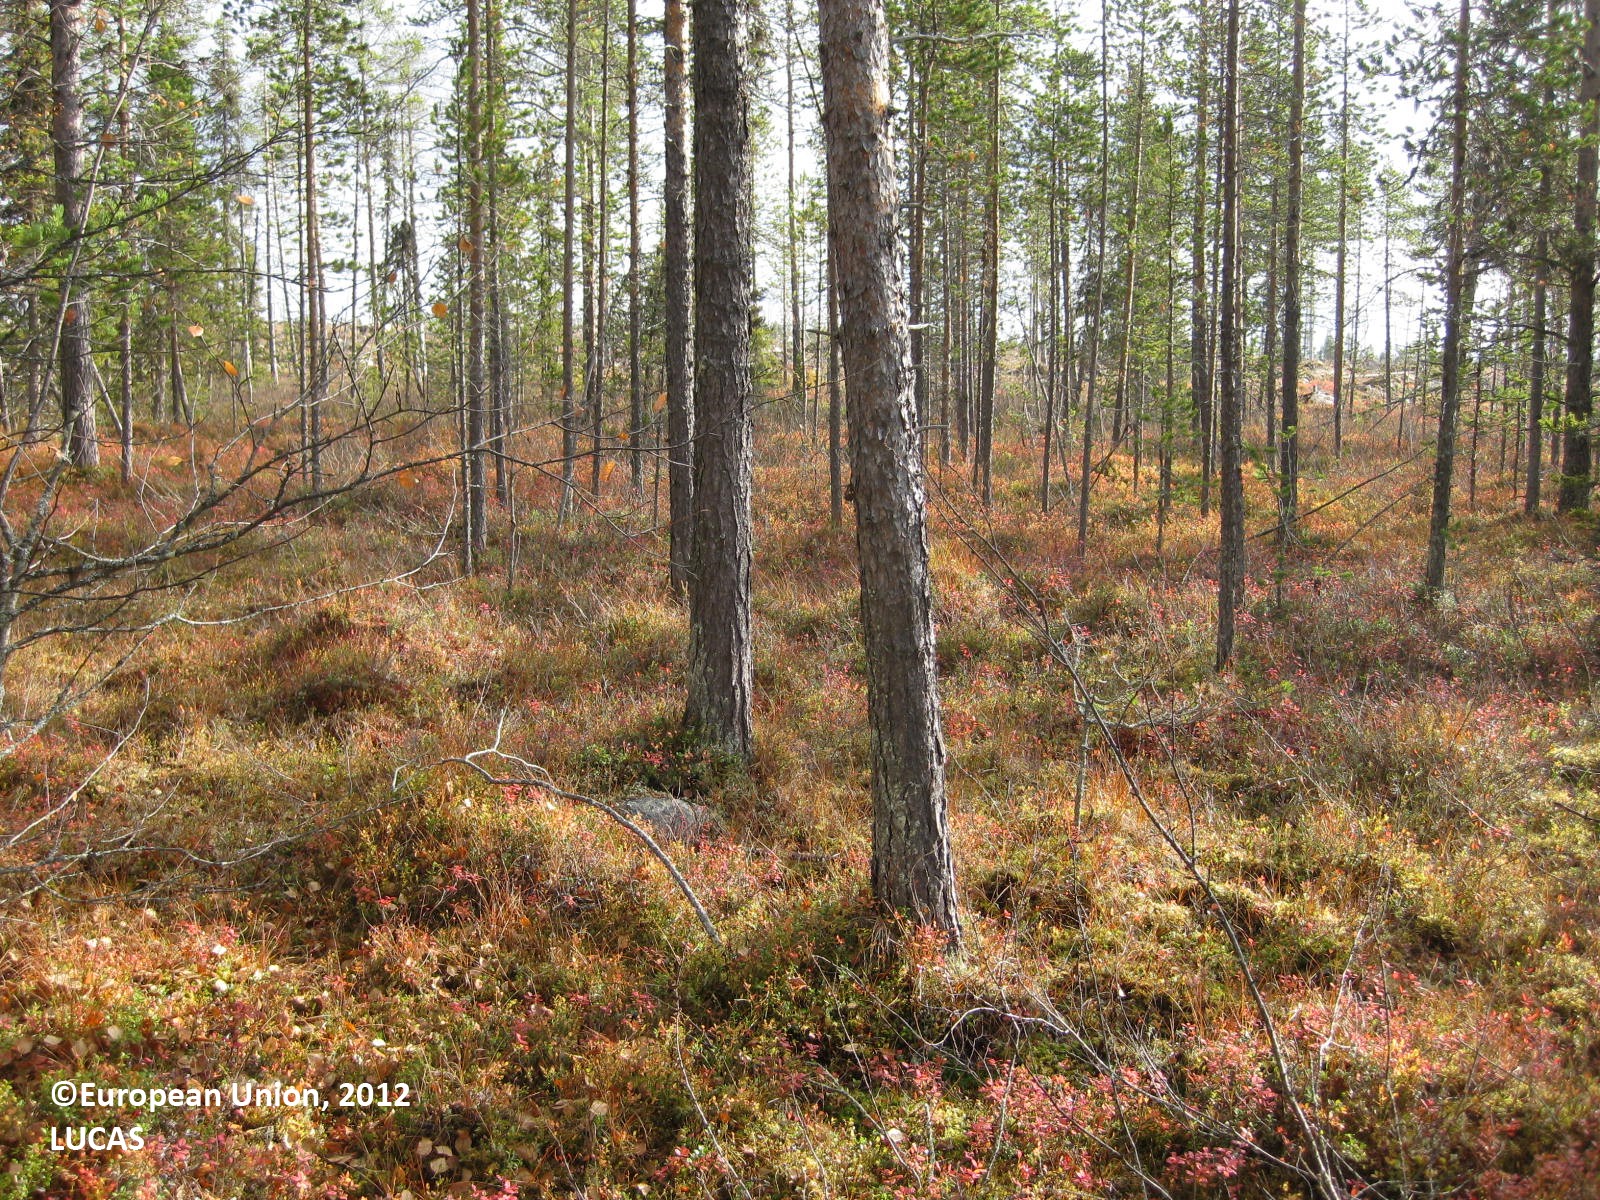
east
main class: Woodland
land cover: Other coniferous woodland
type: boreal forest
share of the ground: > 75 %
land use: Forestry
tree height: > 5 m
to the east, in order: Other coniferous woodland
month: September
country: FI
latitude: 67.9836
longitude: 23.7090
